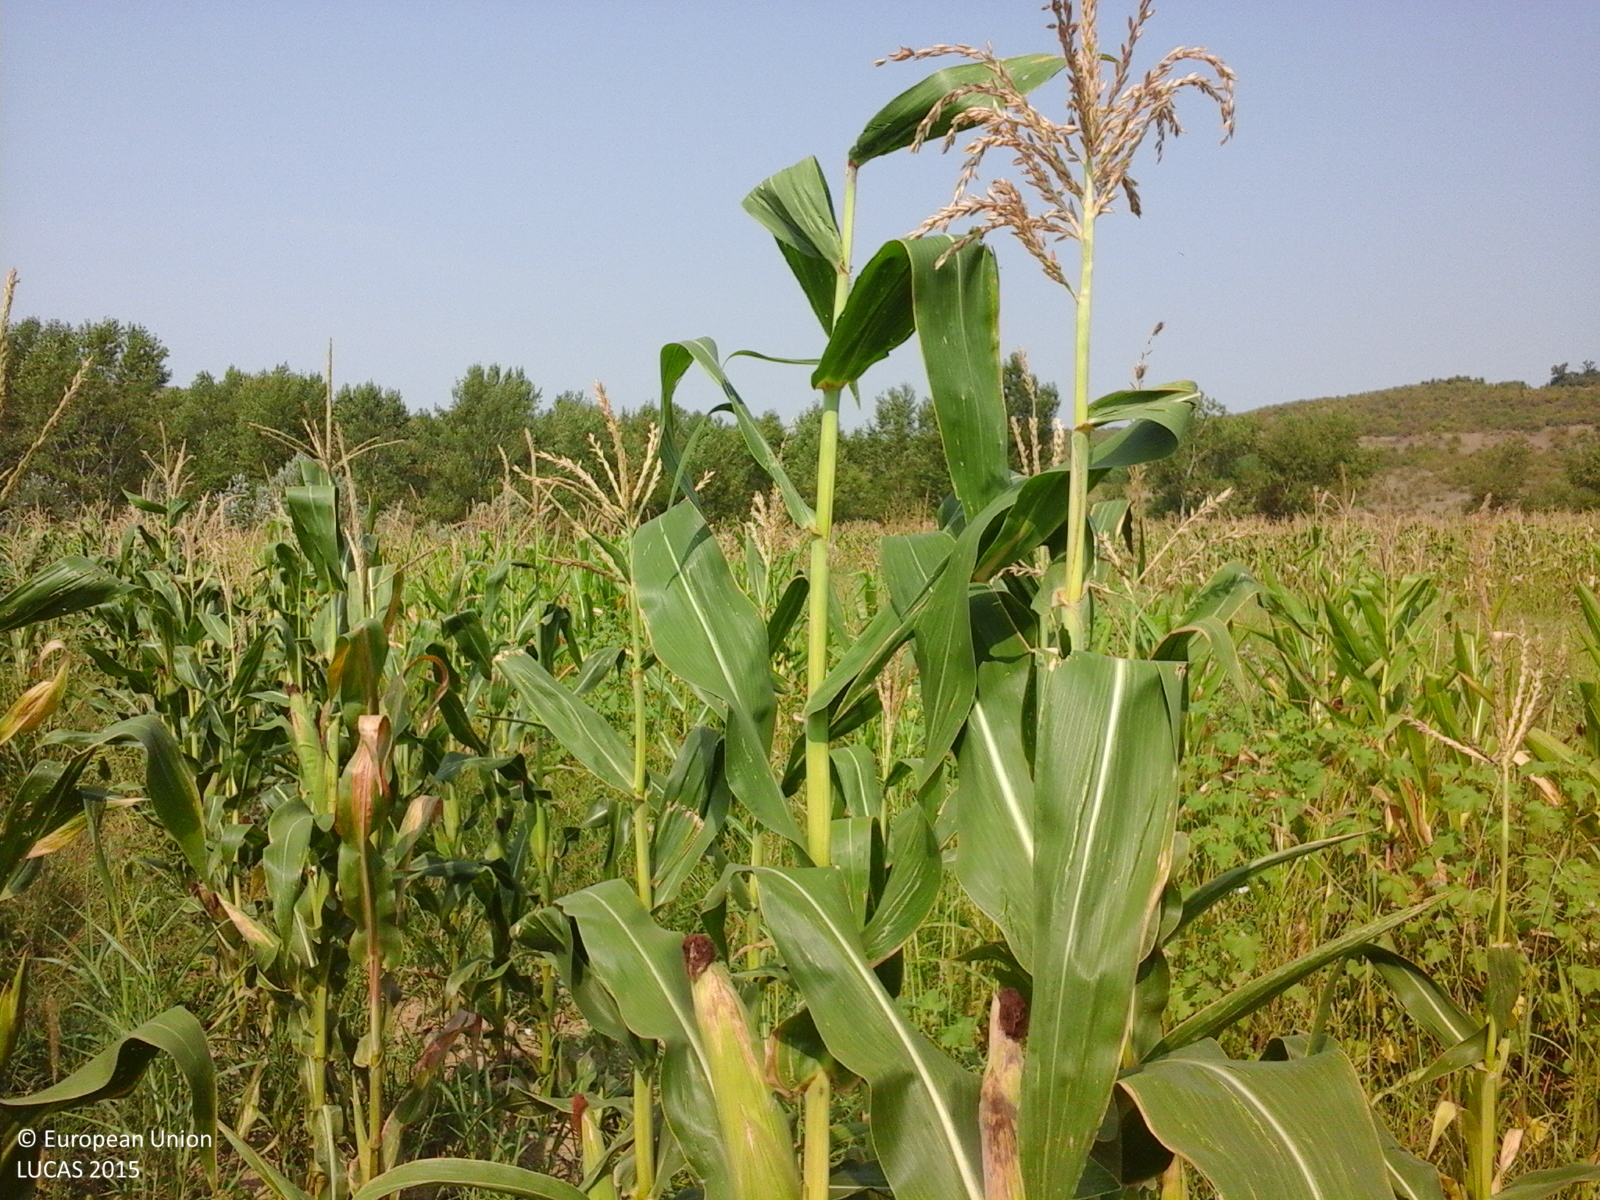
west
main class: Cropland
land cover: Maize
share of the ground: > 75 %
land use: Agriculture (excluding fallow land and kitchen gardens)
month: August
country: RO
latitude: 44.4335
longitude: 23.7631
